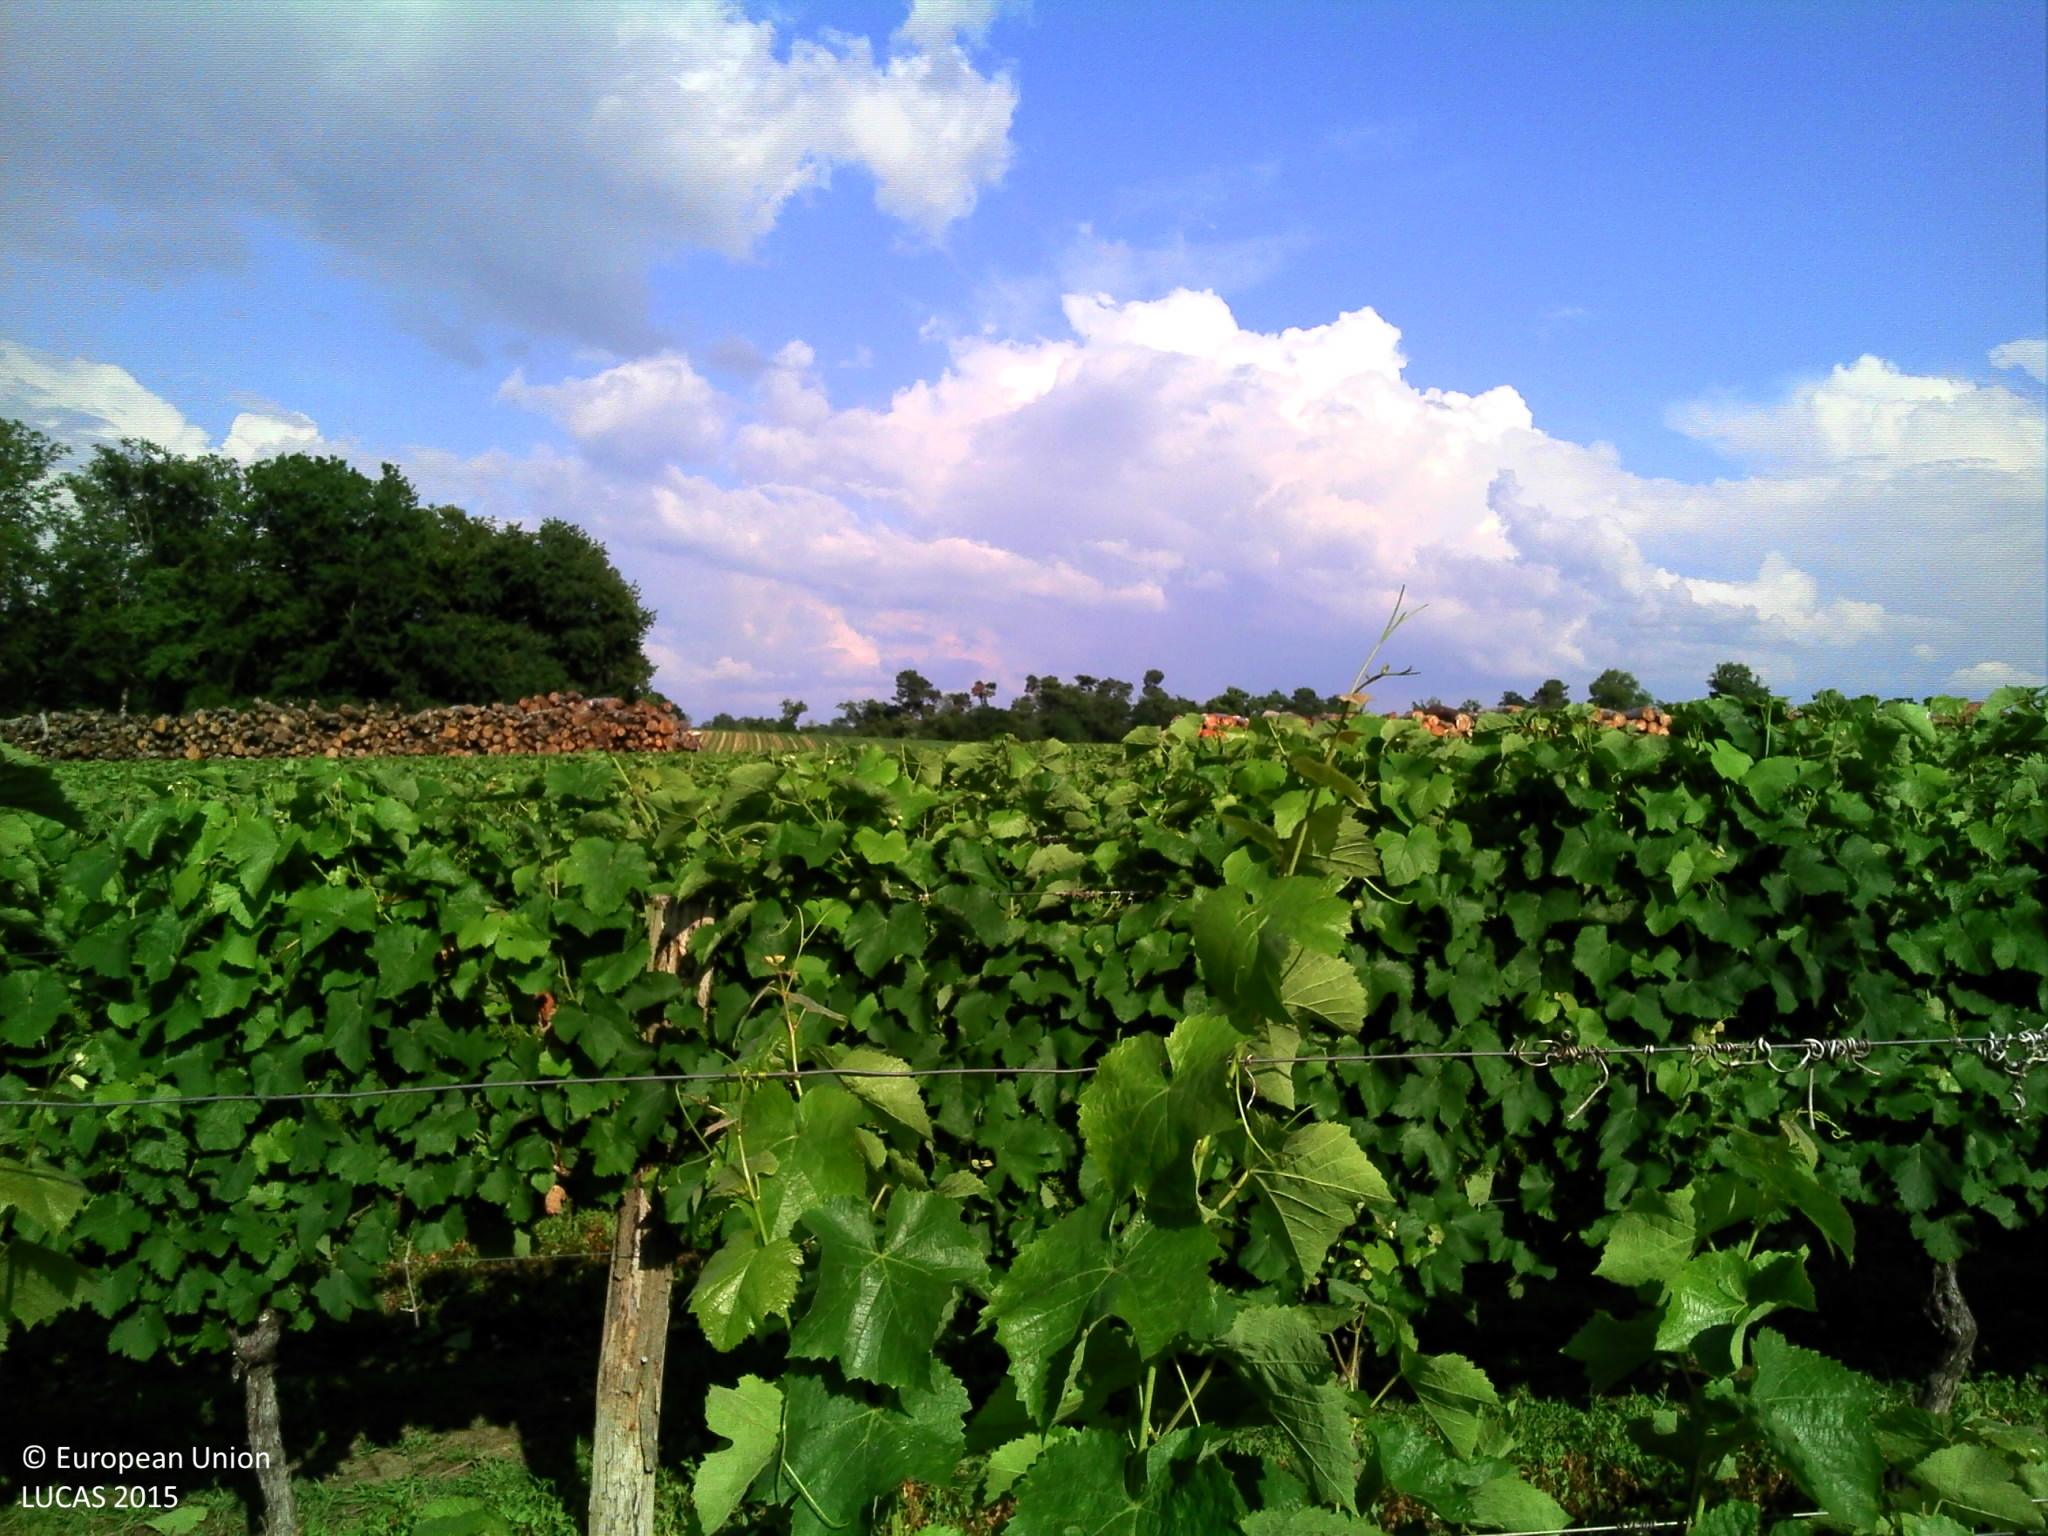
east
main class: Cropland
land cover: Vineyards
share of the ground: 25 - 50 %
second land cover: Grassland without tree/shrub cover
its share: 25 - 50 %
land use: Agriculture (excluding fallow land and kitchen gardens)
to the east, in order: Vineyards; Grassland without tree/shrub cover; Tracks; Grass margins; Grassland without tree/shrub cover; Broadleaved woodland; Grass margins; Maize
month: June
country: FR
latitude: 43.8421
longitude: -0.2459
